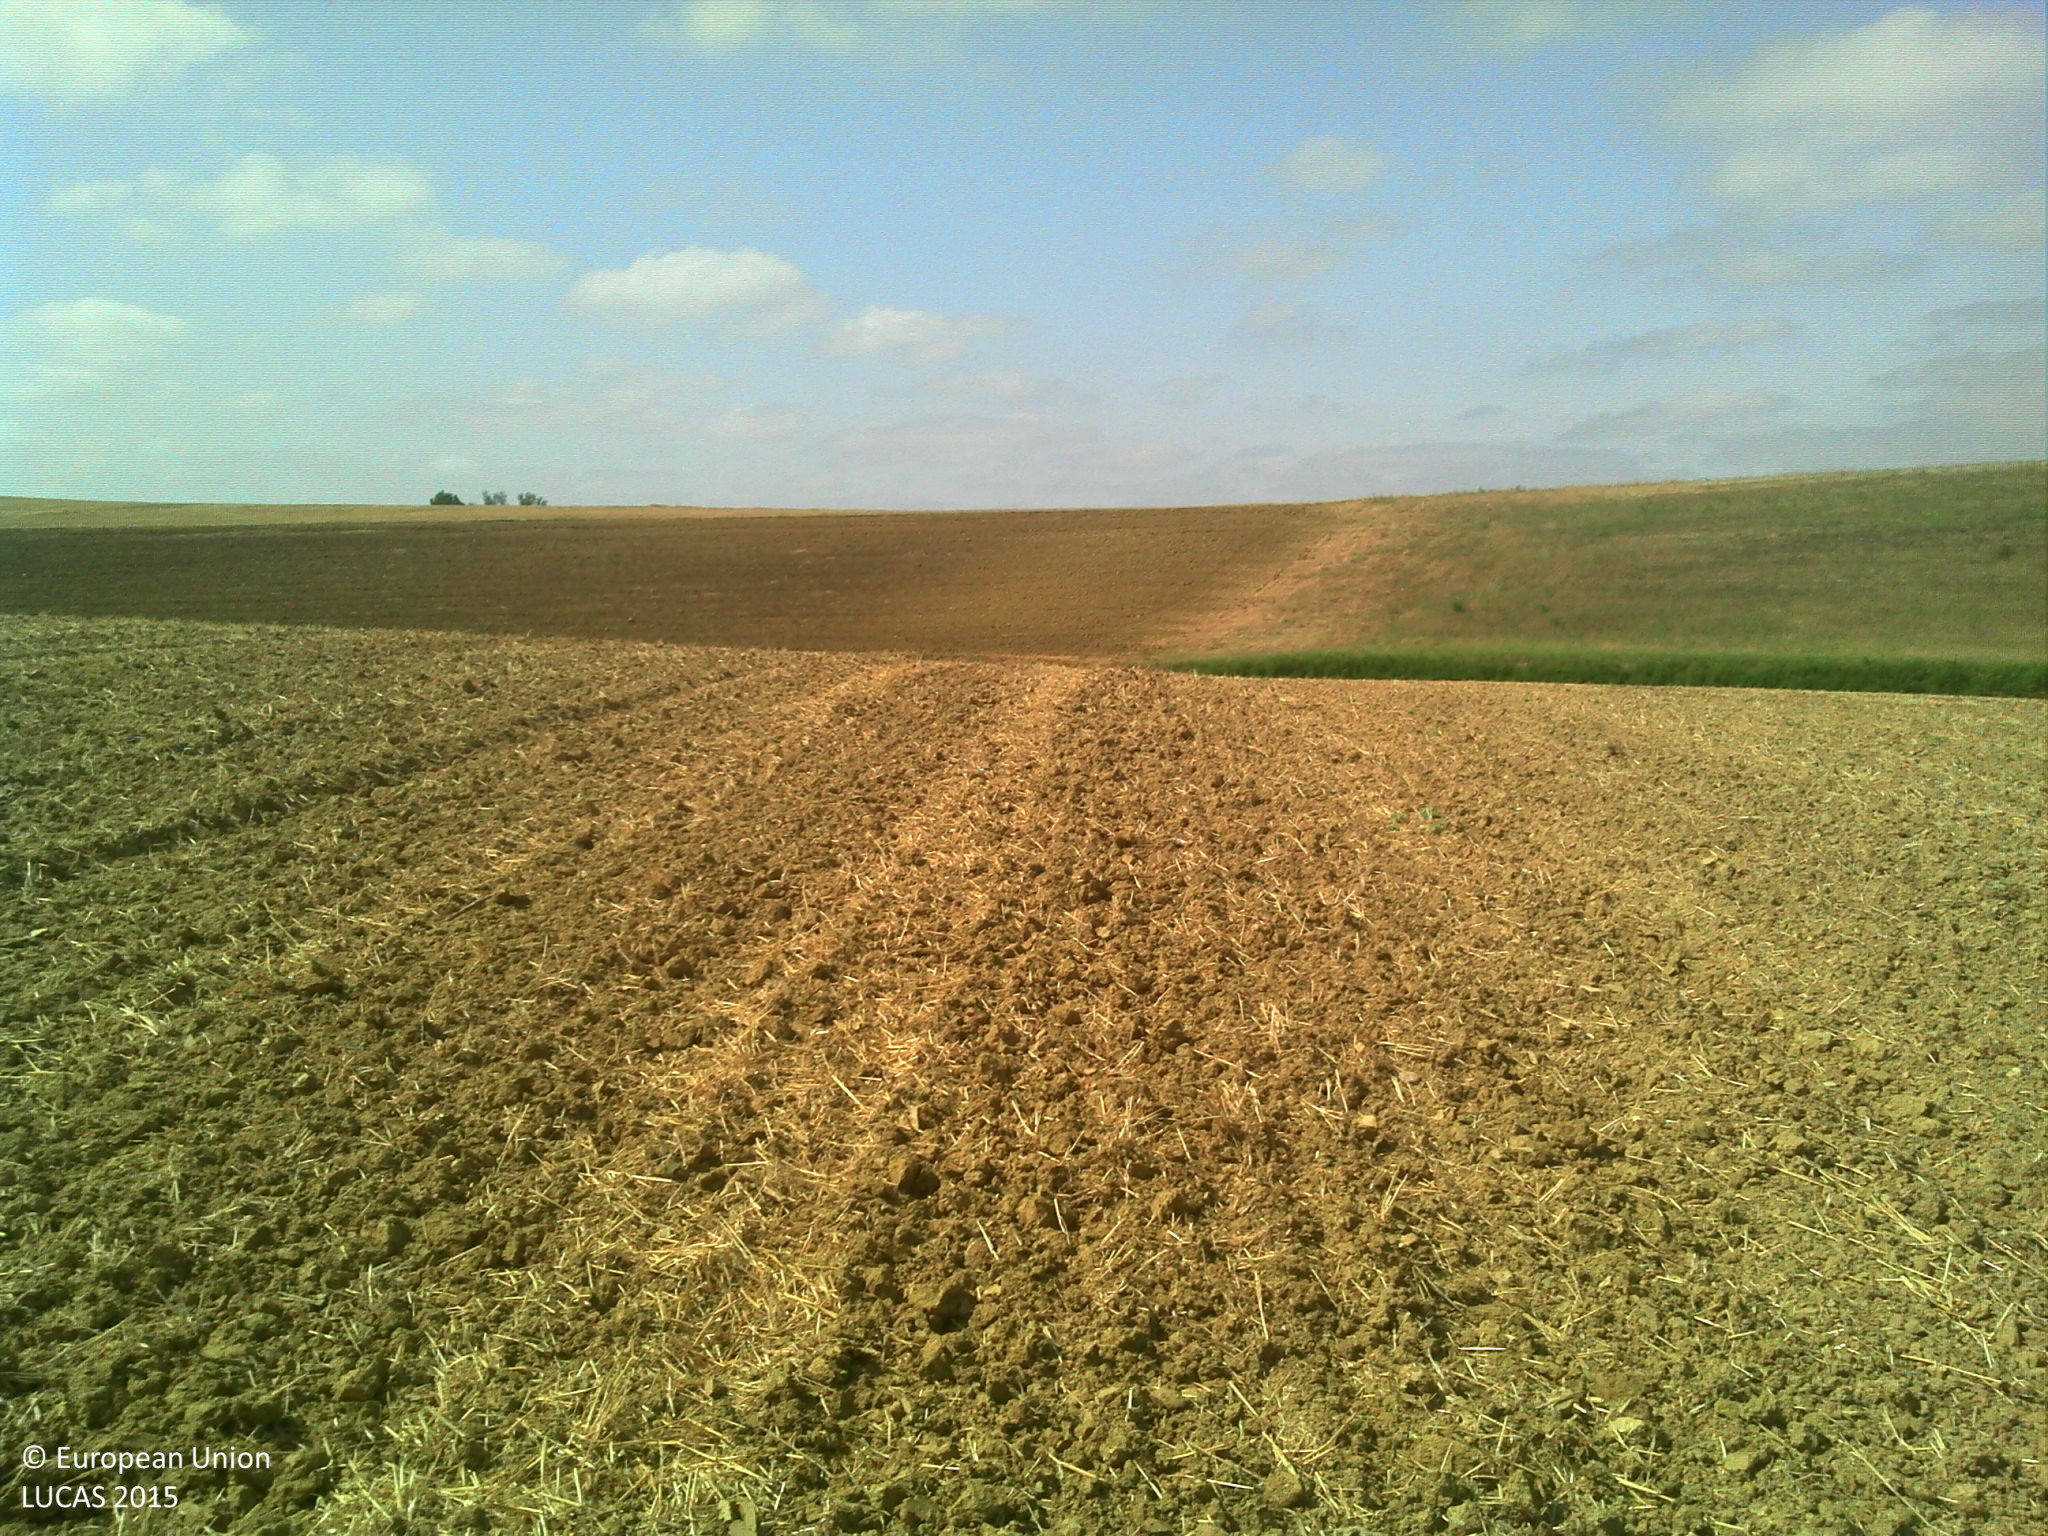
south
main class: Cropland
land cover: Common wheat
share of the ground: < 10 %
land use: Agriculture (excluding fallow land and kitchen gardens)
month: July
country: FR
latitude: 43.8504
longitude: 1.0051
